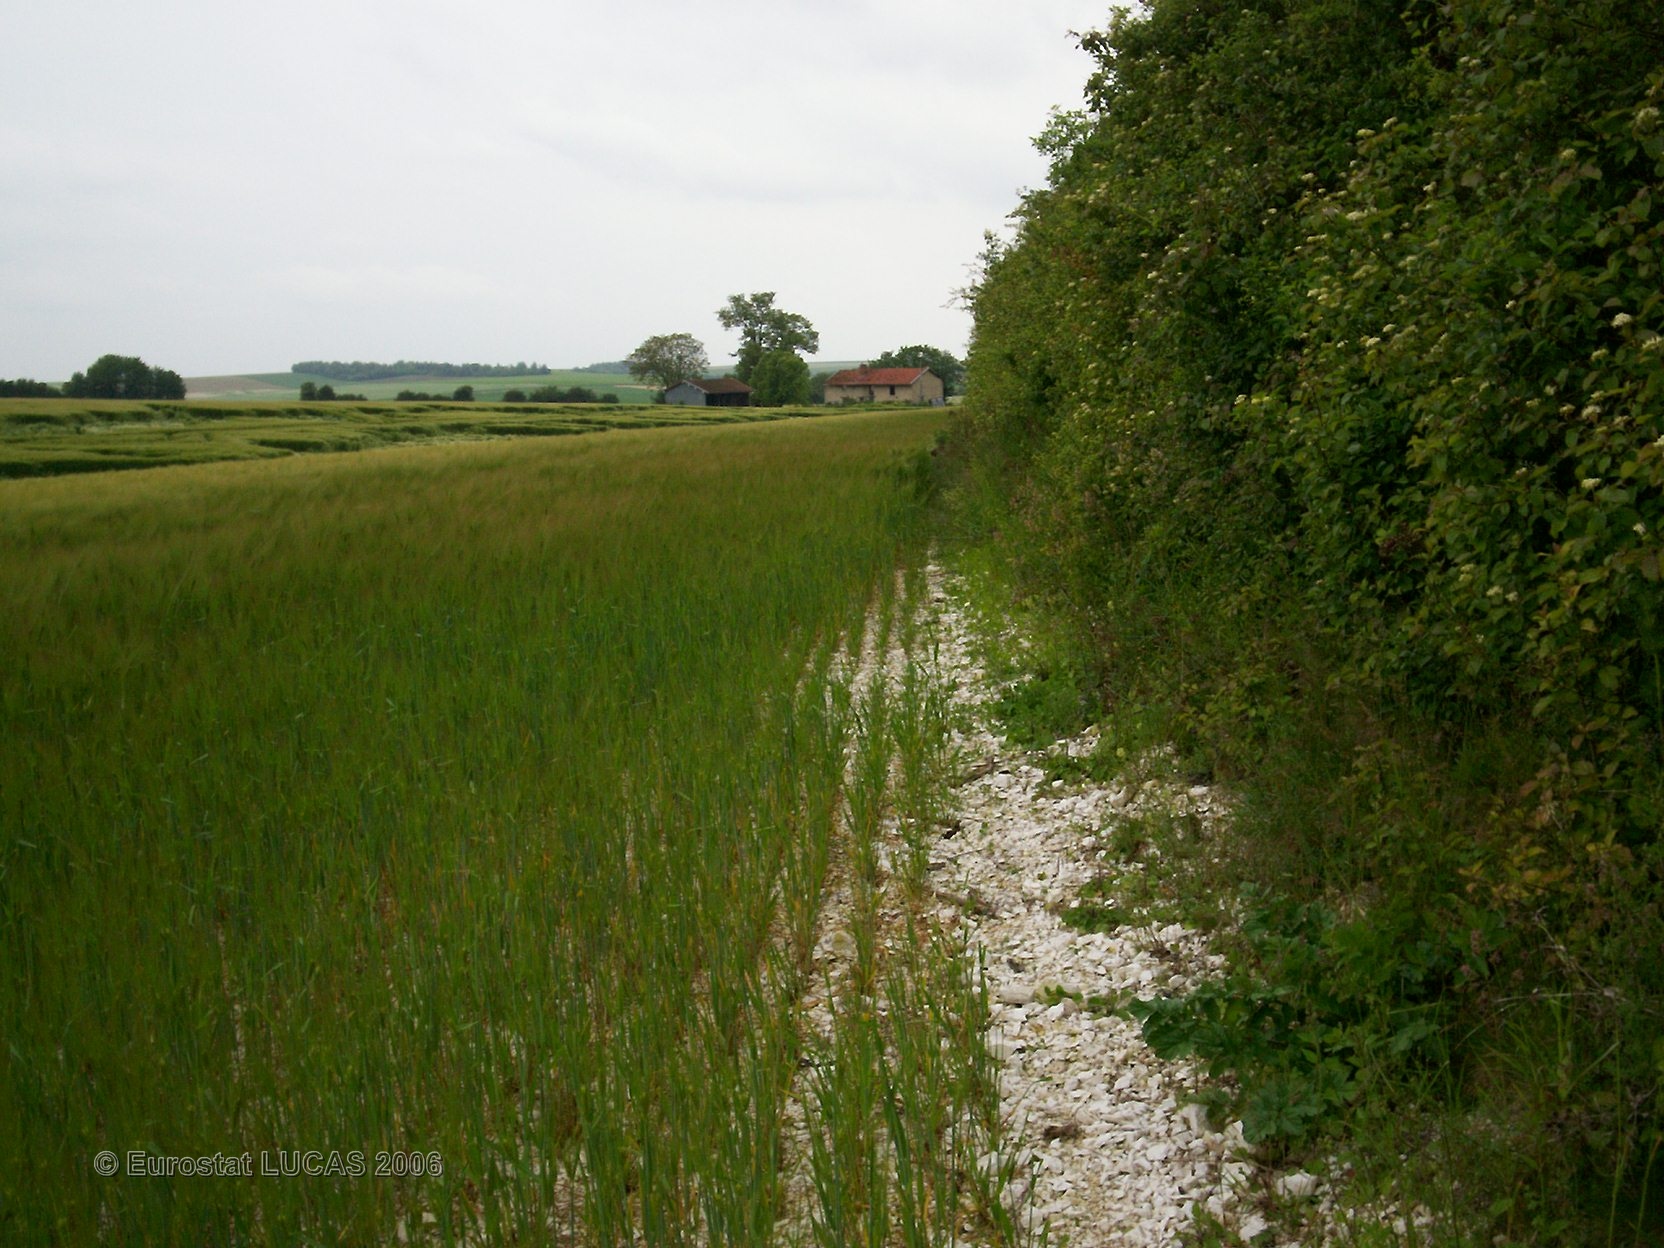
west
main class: Cropland
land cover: Barley
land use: Agriculture (excluding fallow land and kitchen gardens)
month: June
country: FR
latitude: 48.6785
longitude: 4.4420
